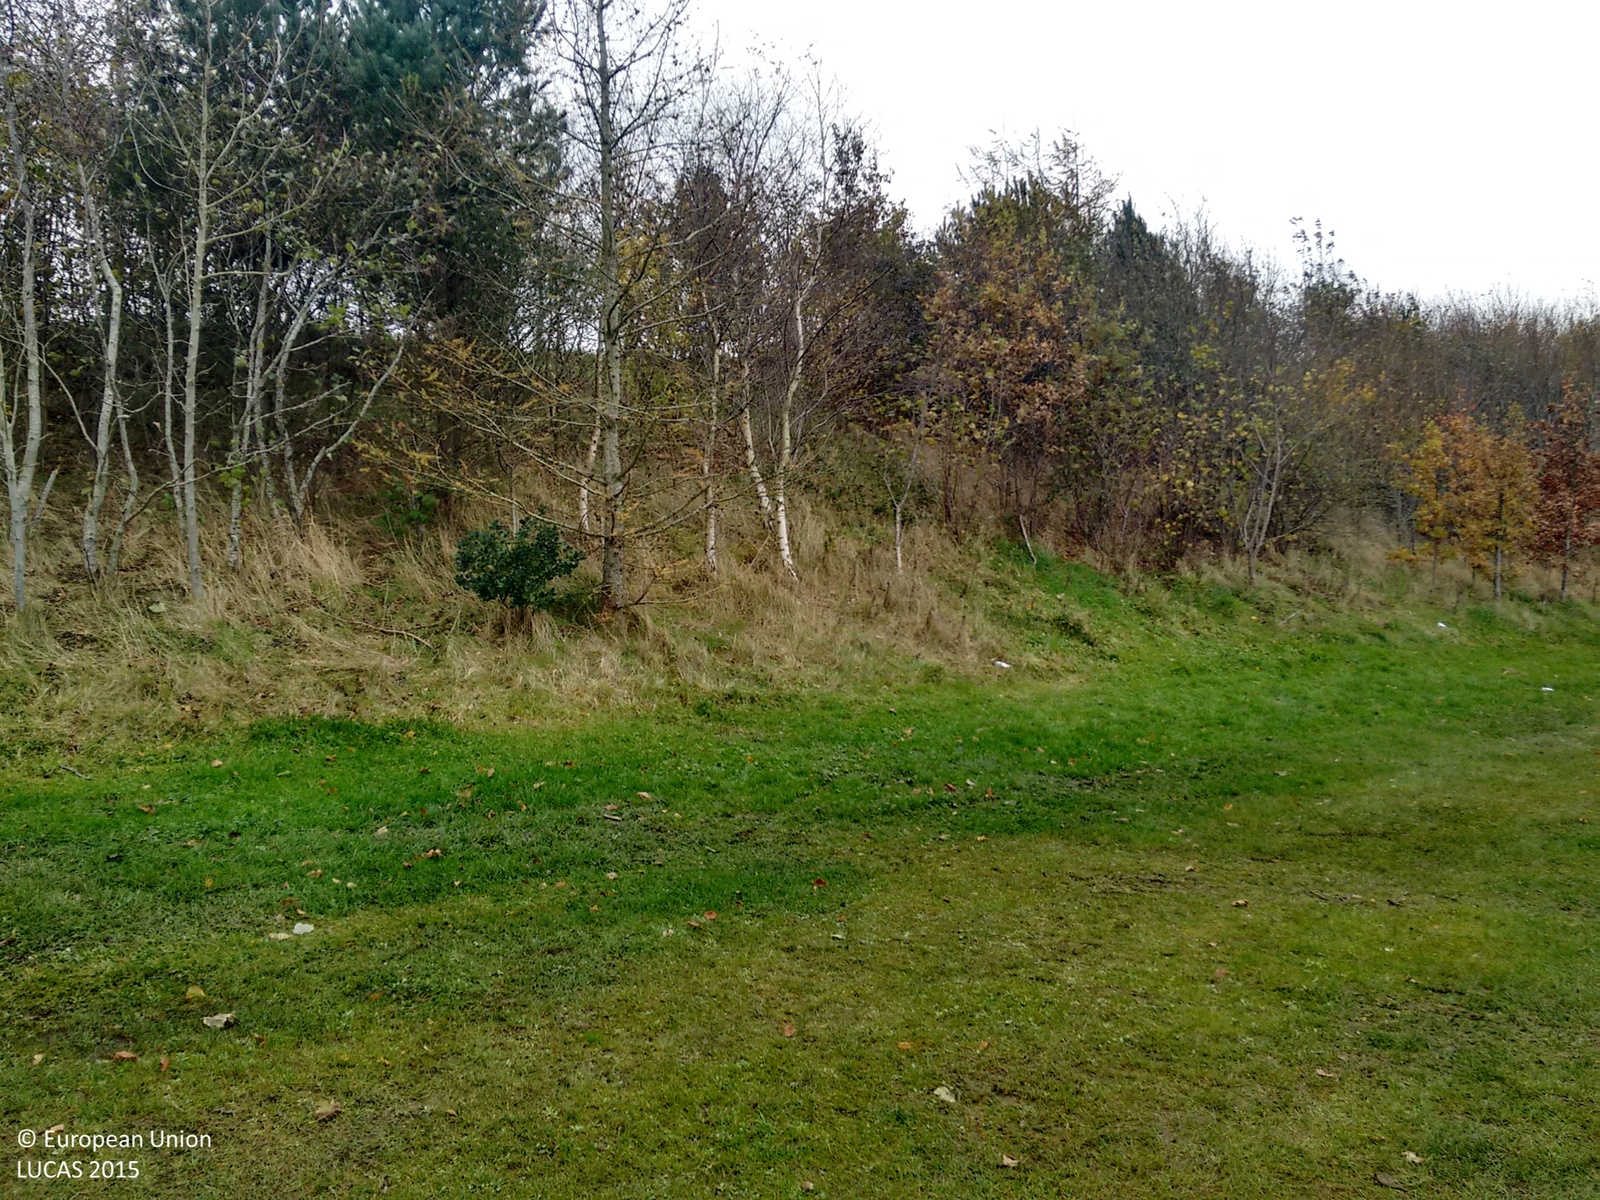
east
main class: Grassland
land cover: Grassland without tree/shrub cover
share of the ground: > 75 %
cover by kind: herbaceous plants 100 %
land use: Sport
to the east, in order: Grassland without tree/shrub cover; Other mixed woodland; Grassland without tree/shrub cover; Ditches and canals; Fences; Grassland without tree/shrub cover; Lines of trees; Electric lines; Grassland without tree/shrub cover
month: November
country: GB
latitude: 54.5785
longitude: -5.7758
